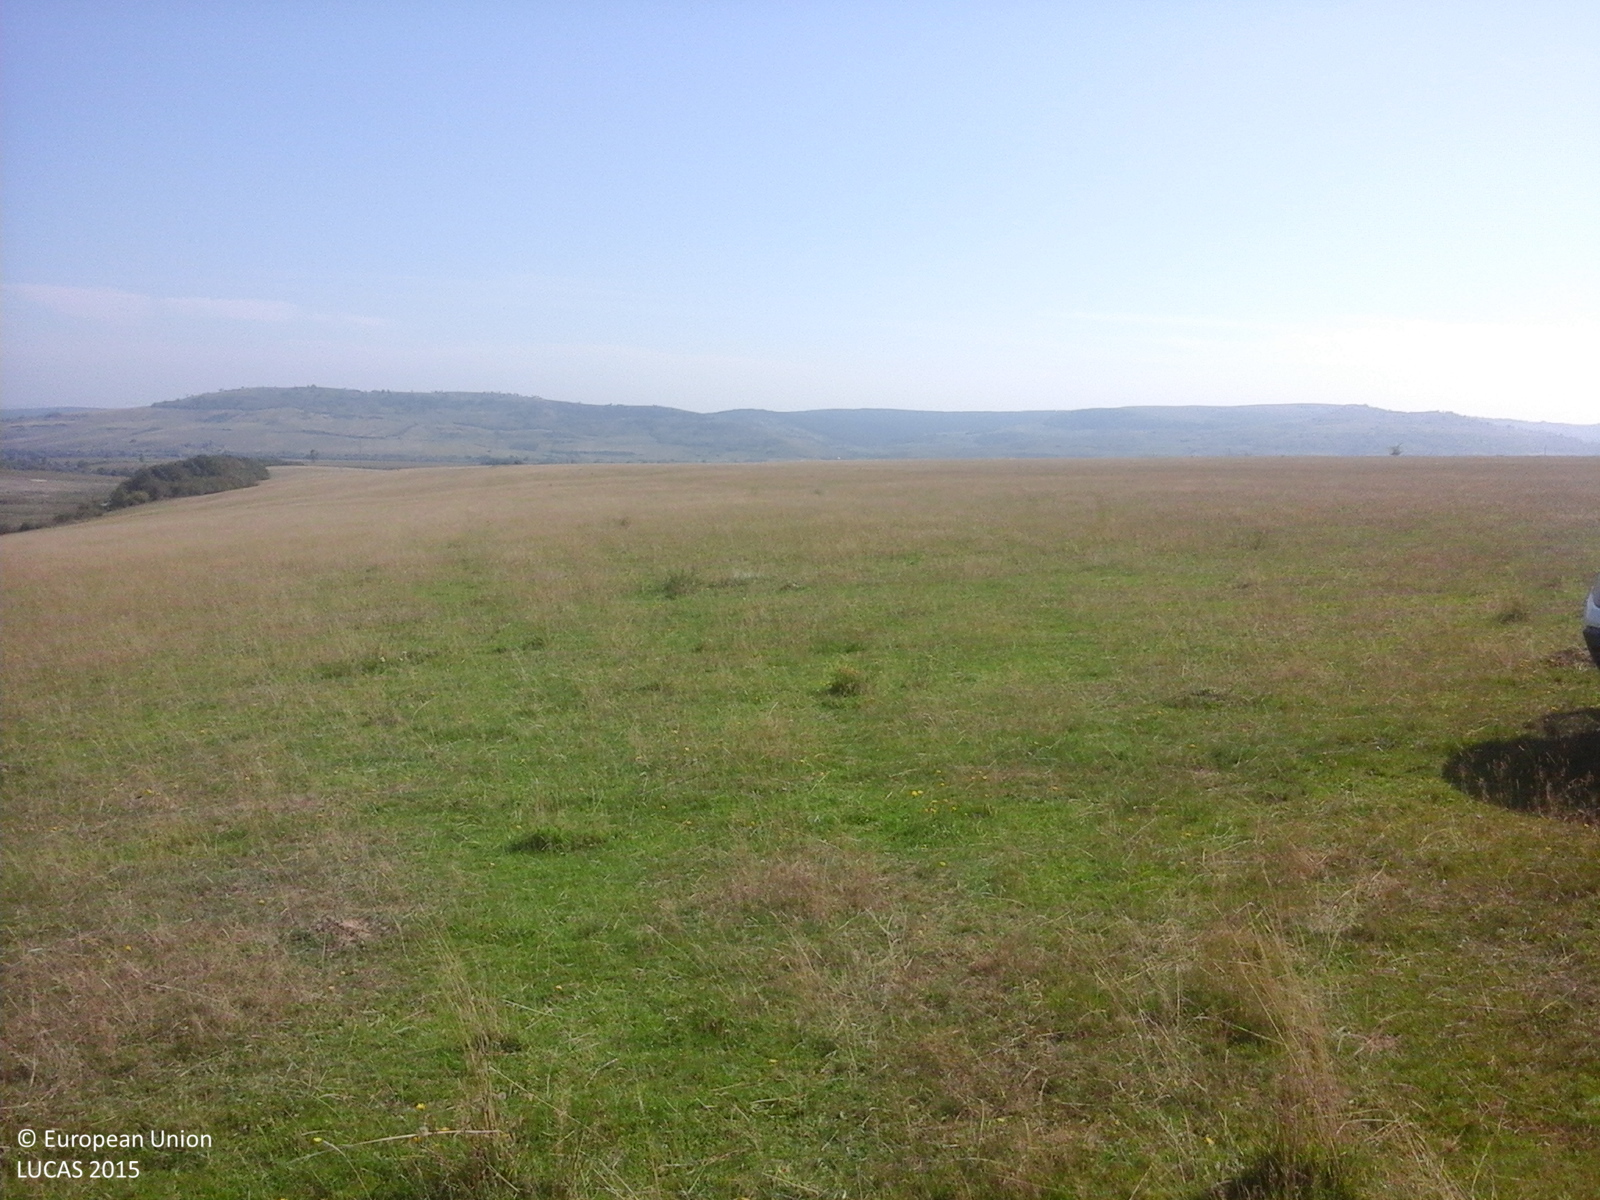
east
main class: Grassland
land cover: Grassland without tree/shrub cover
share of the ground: > 75 %
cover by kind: herbaceous plants 100 %
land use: Agriculture (excluding fallow land and kitchen gardens)
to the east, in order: Grassland without tree/shrub cover
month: September
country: RO
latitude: 47.4076
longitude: 22.7425
